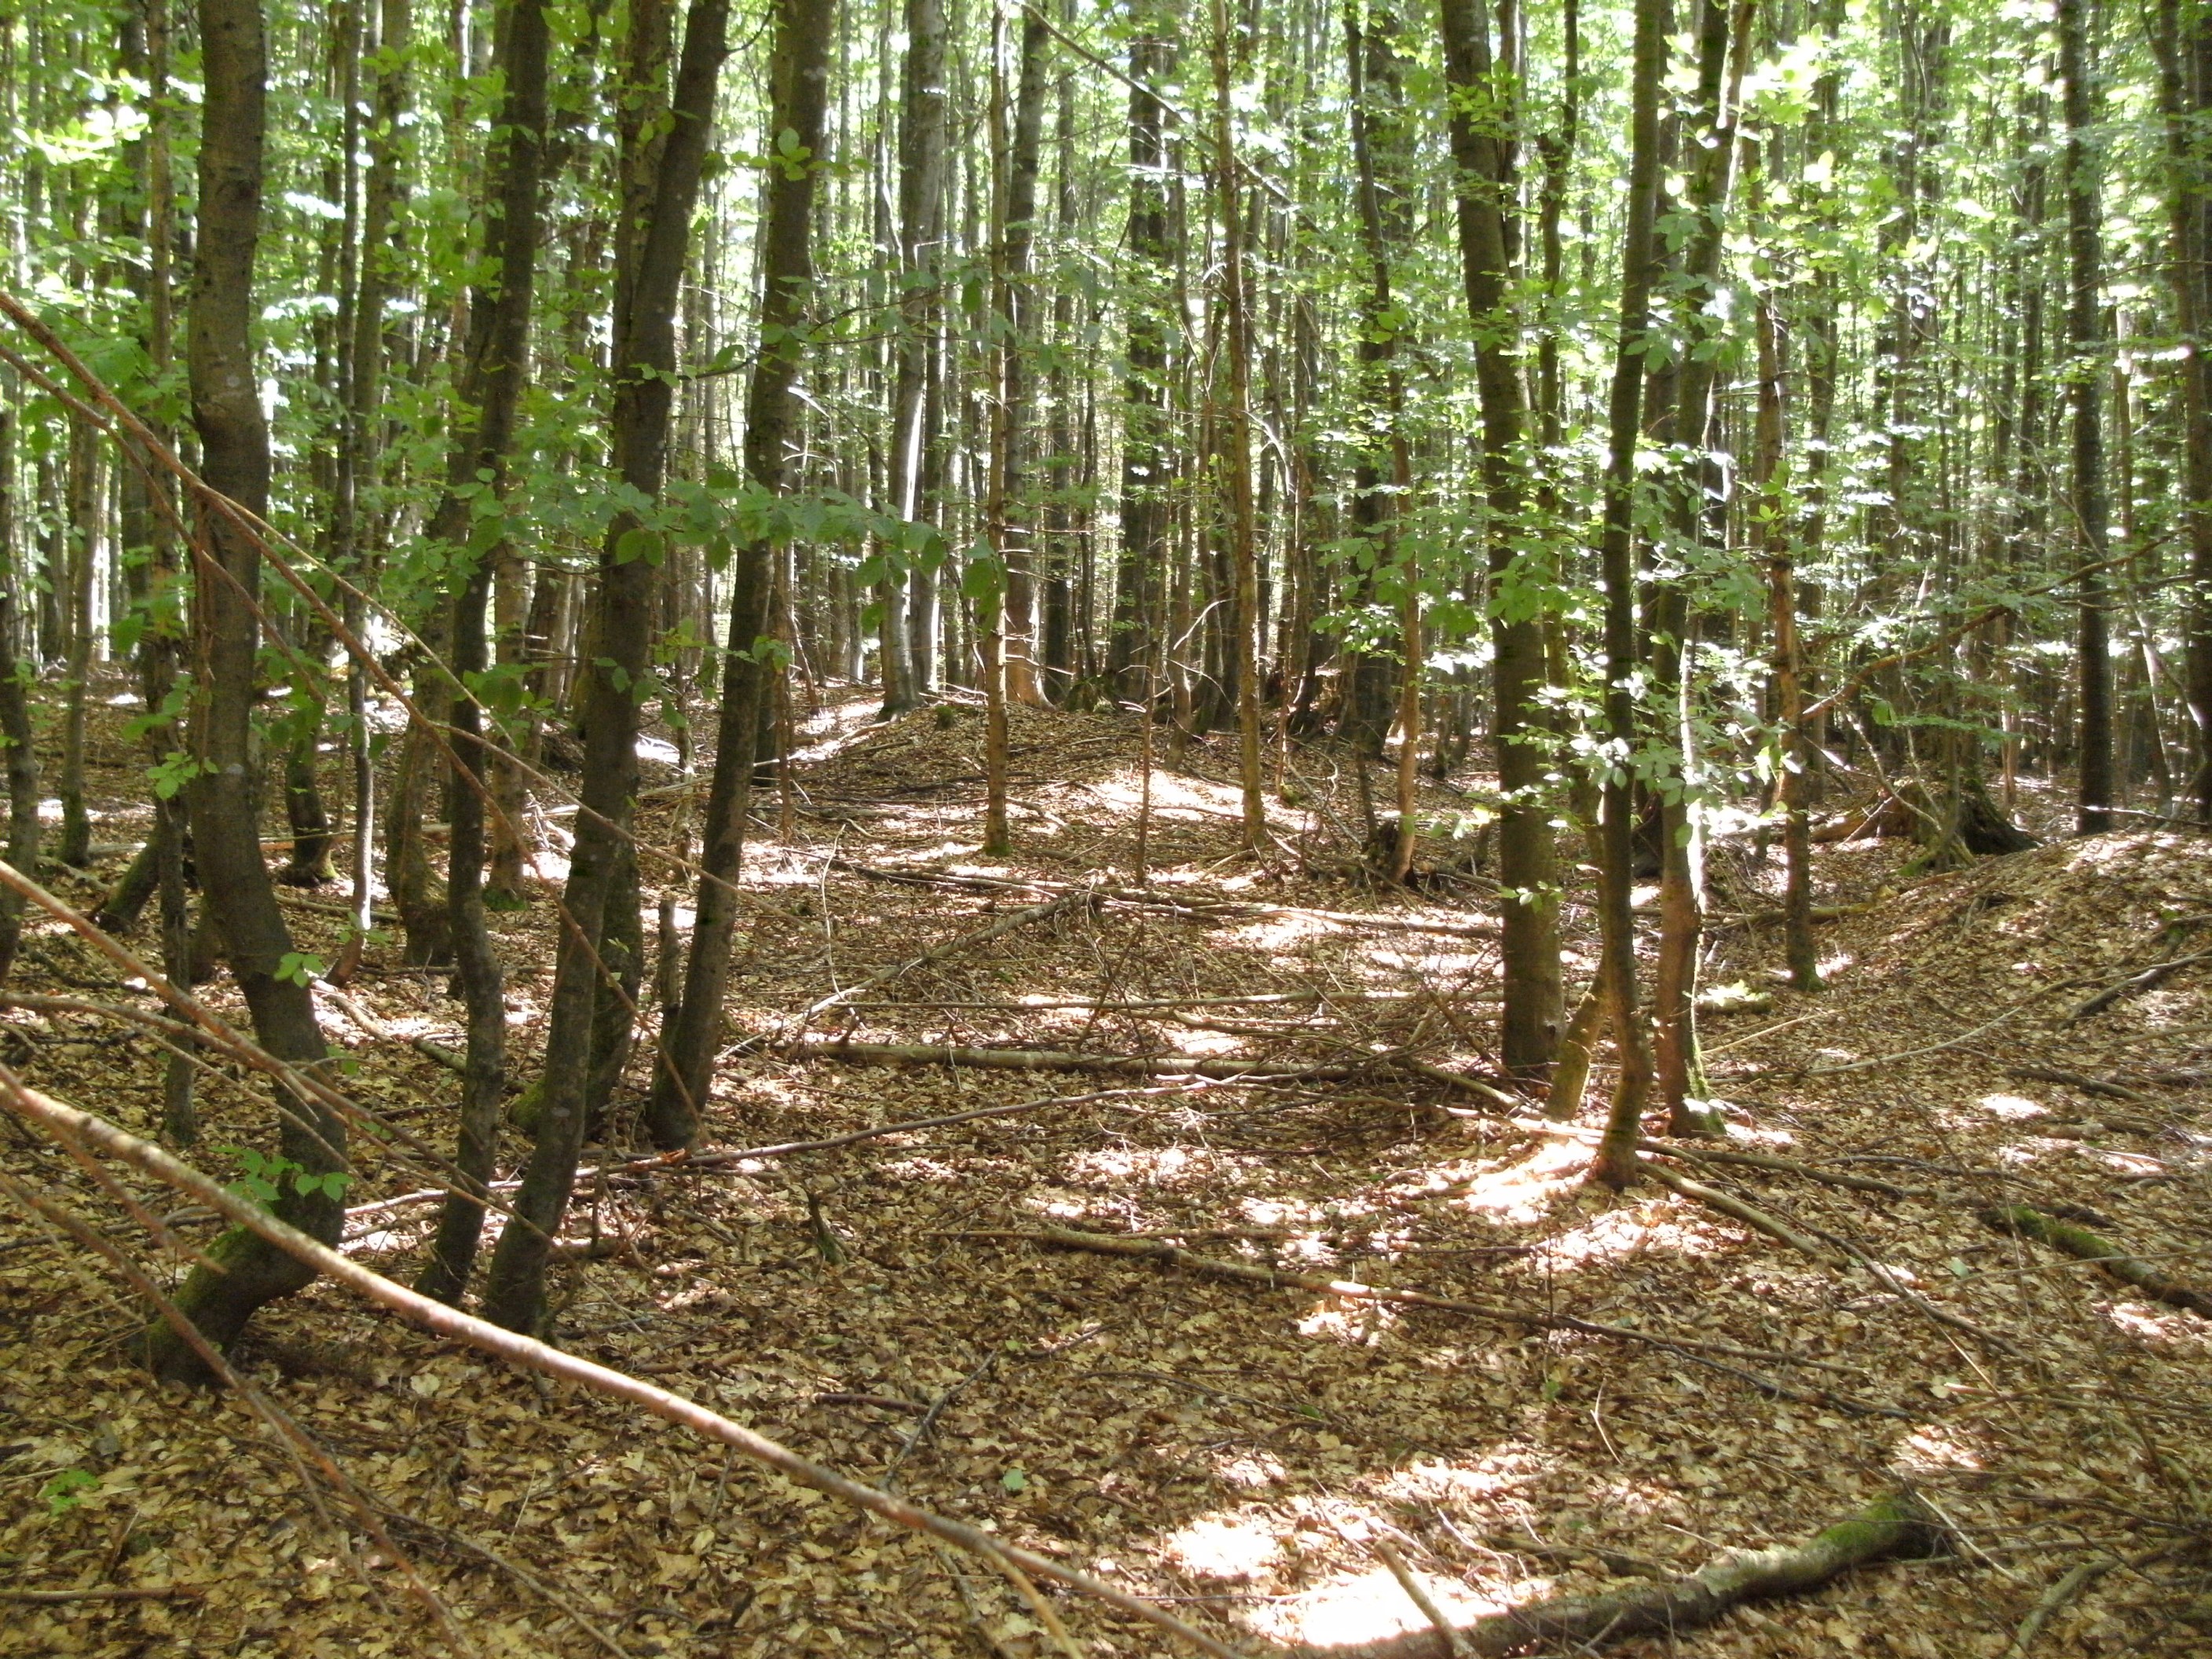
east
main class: Woodland
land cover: Broadleaved woodland
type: beech forest
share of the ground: > 75 %
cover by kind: broadleaved forest trees 85 %, coniferous forest trees 10 %, unconsolidated bare surface 5 %
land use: Forestry
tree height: > 5 m
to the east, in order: Broadleaved woodland; Spruce dominated mixed woodland; Tracks; Spruce dominated mixed woodland
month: June
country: AT
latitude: 48.0461
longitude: 13.3660
